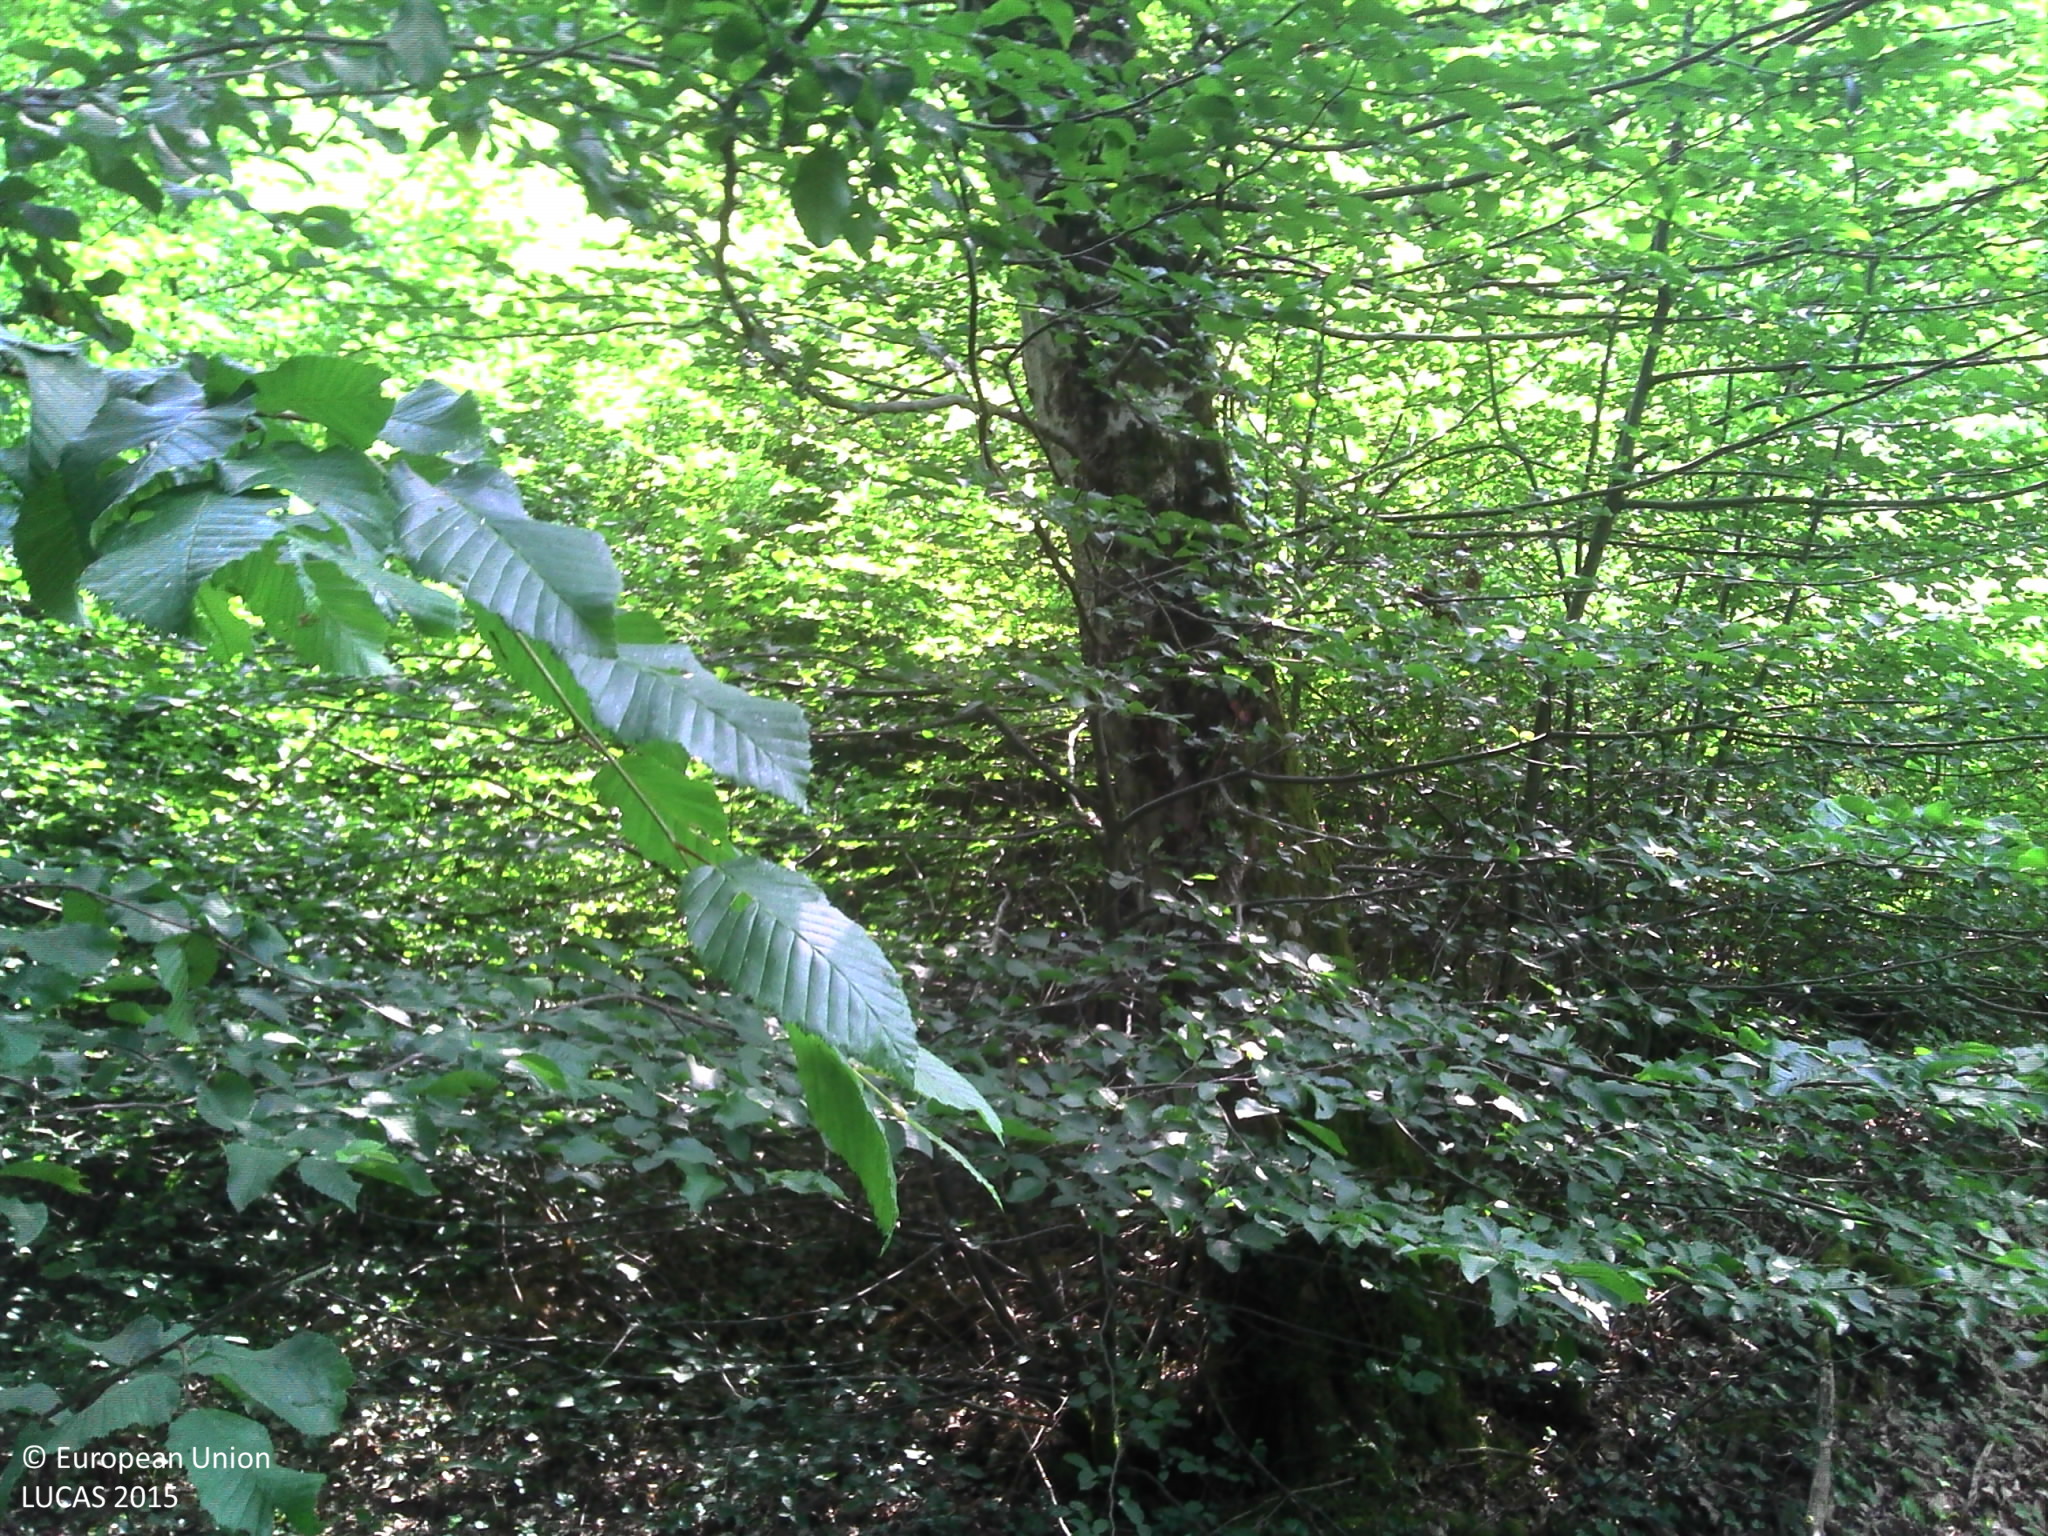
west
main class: Woodland
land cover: Broadleaved woodland
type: mesophytic deciduous forest
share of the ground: > 75 %
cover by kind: broadleaved forest trees 65 %, coniferous forest trees 20 %, herbaceous plants 15 %
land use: Forestry
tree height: > 5 m
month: June
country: FR
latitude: 46.4827
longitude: 4.5435
